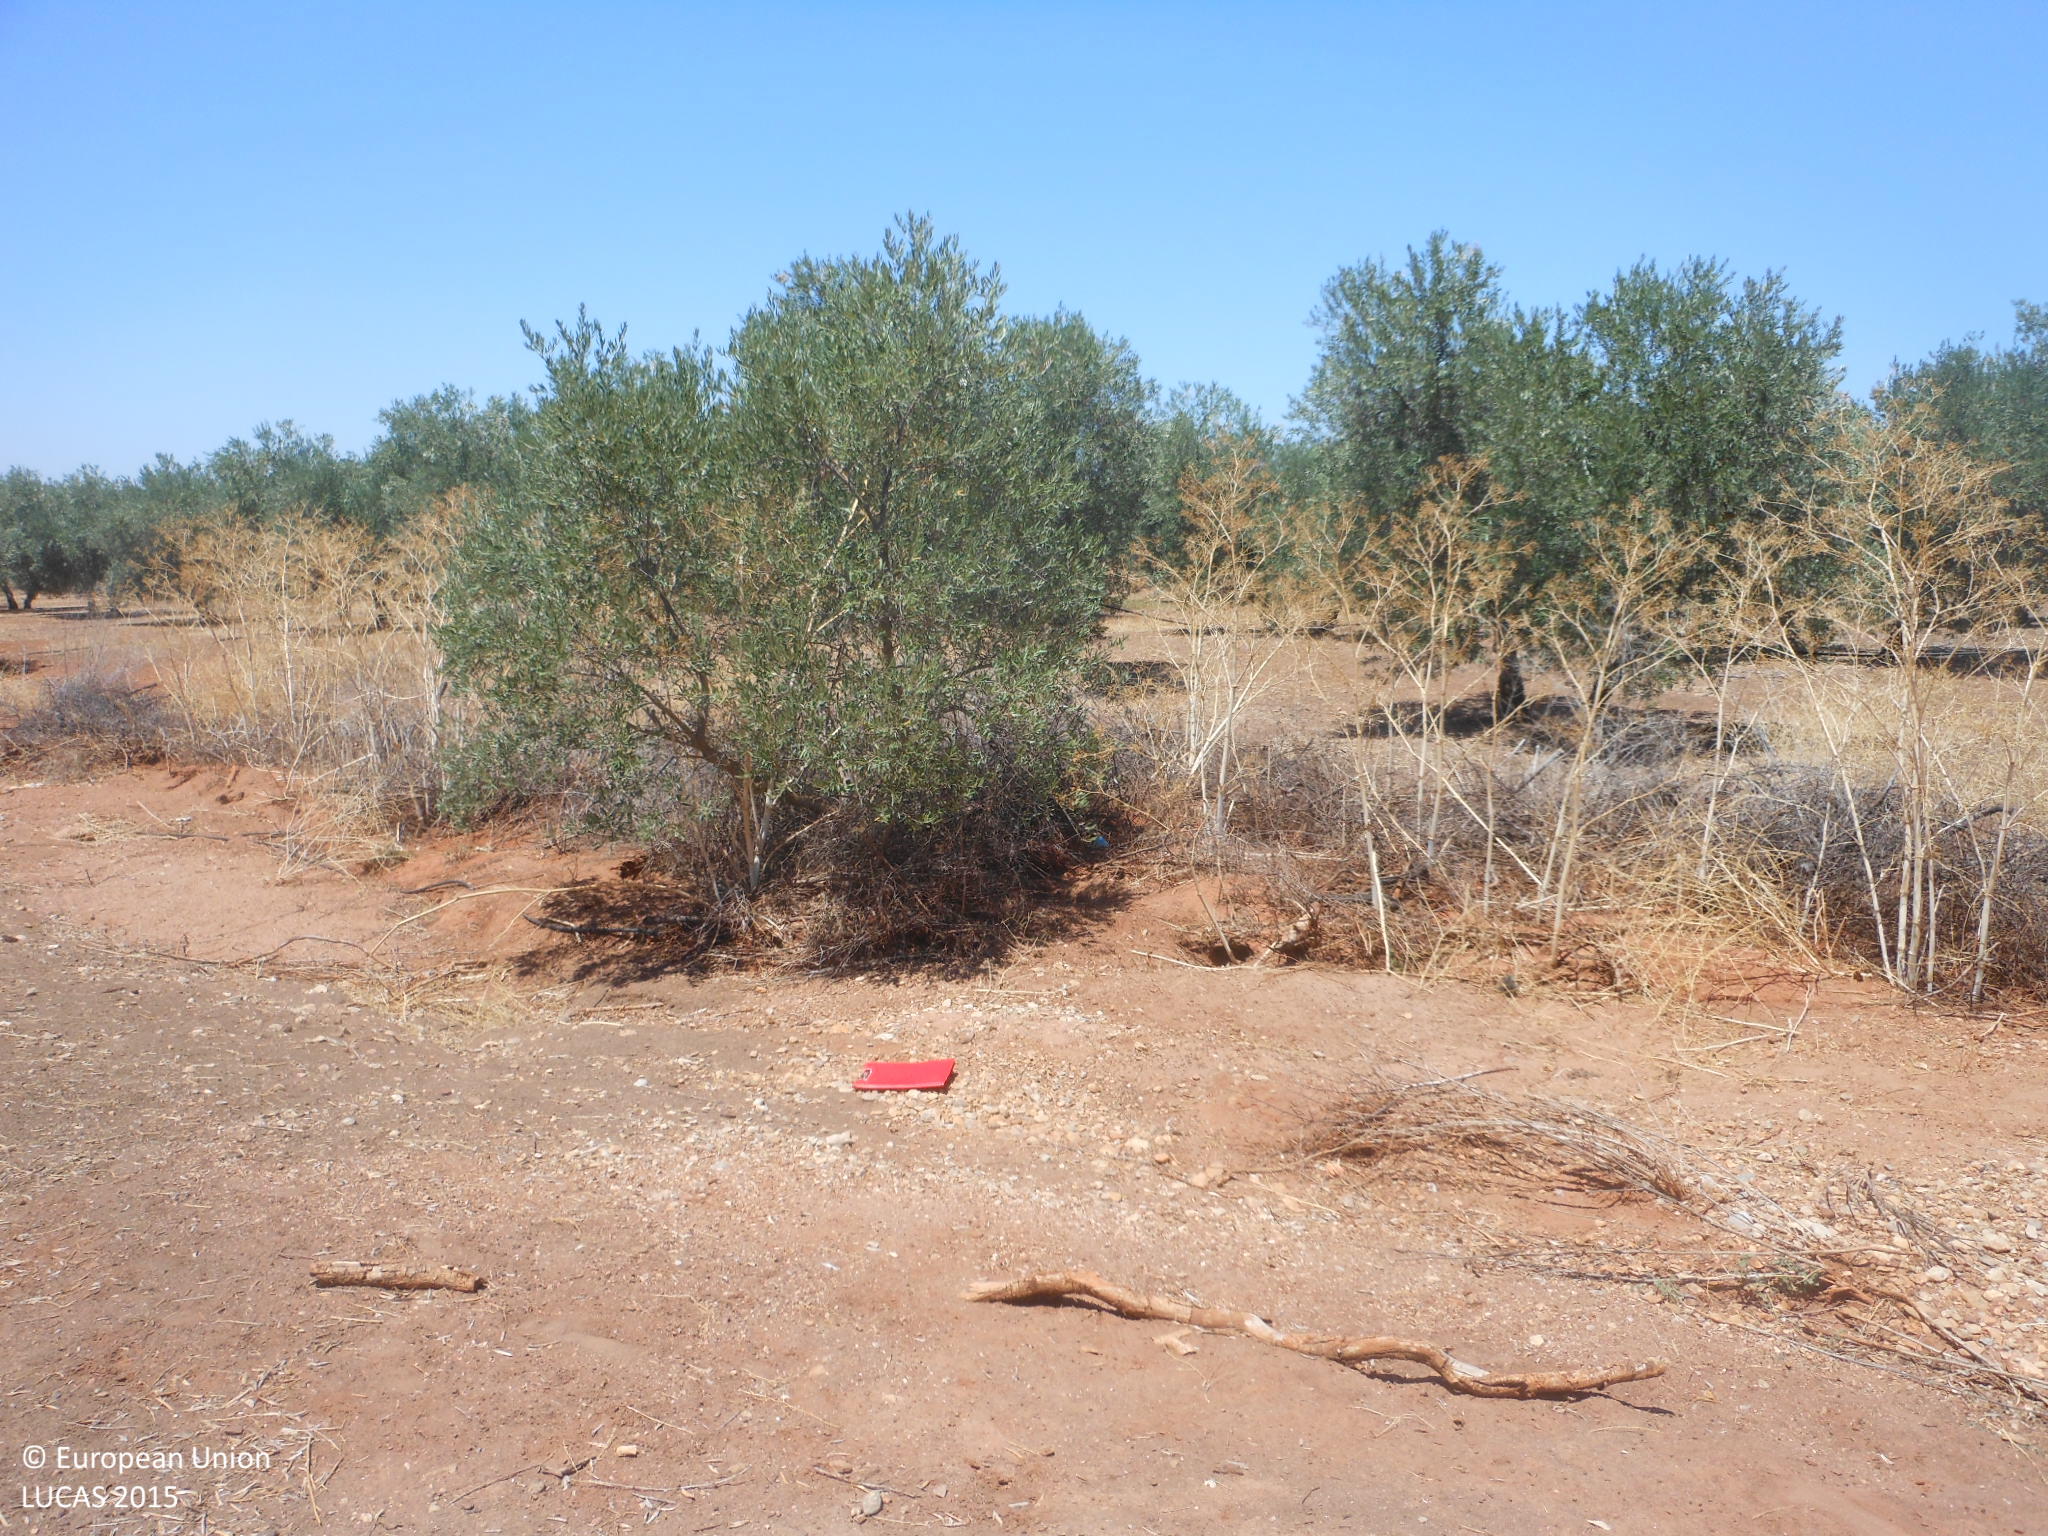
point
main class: Cropland
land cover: Olive groves
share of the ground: 50 - 75 %
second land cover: Spontaneously vegetated surfaces
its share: 10 - 25 %
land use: Agriculture (excluding fallow land and kitchen gardens)
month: July
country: ES
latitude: 37.2690
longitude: -5.3366
